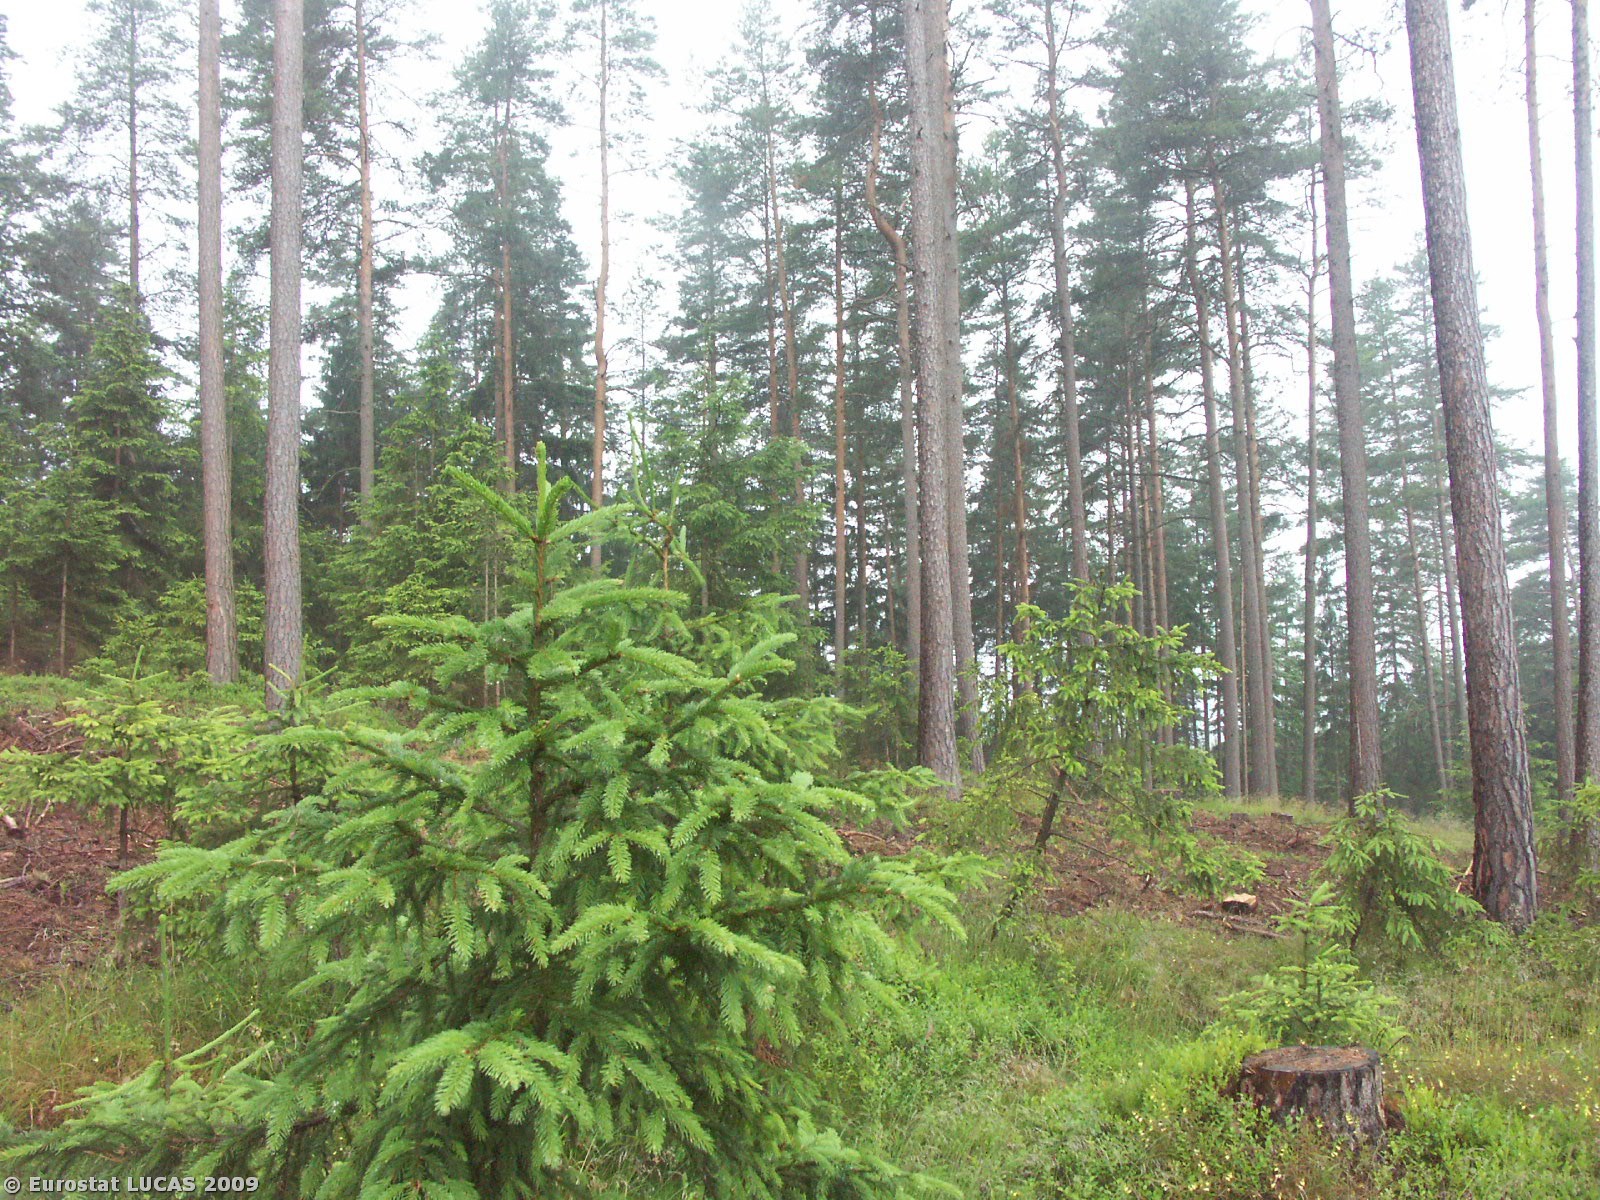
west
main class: Woodland
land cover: Coniferous woodland
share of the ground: > 75 %
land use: Forestry
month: June
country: CZ
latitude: 48.7529
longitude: 14.2851
